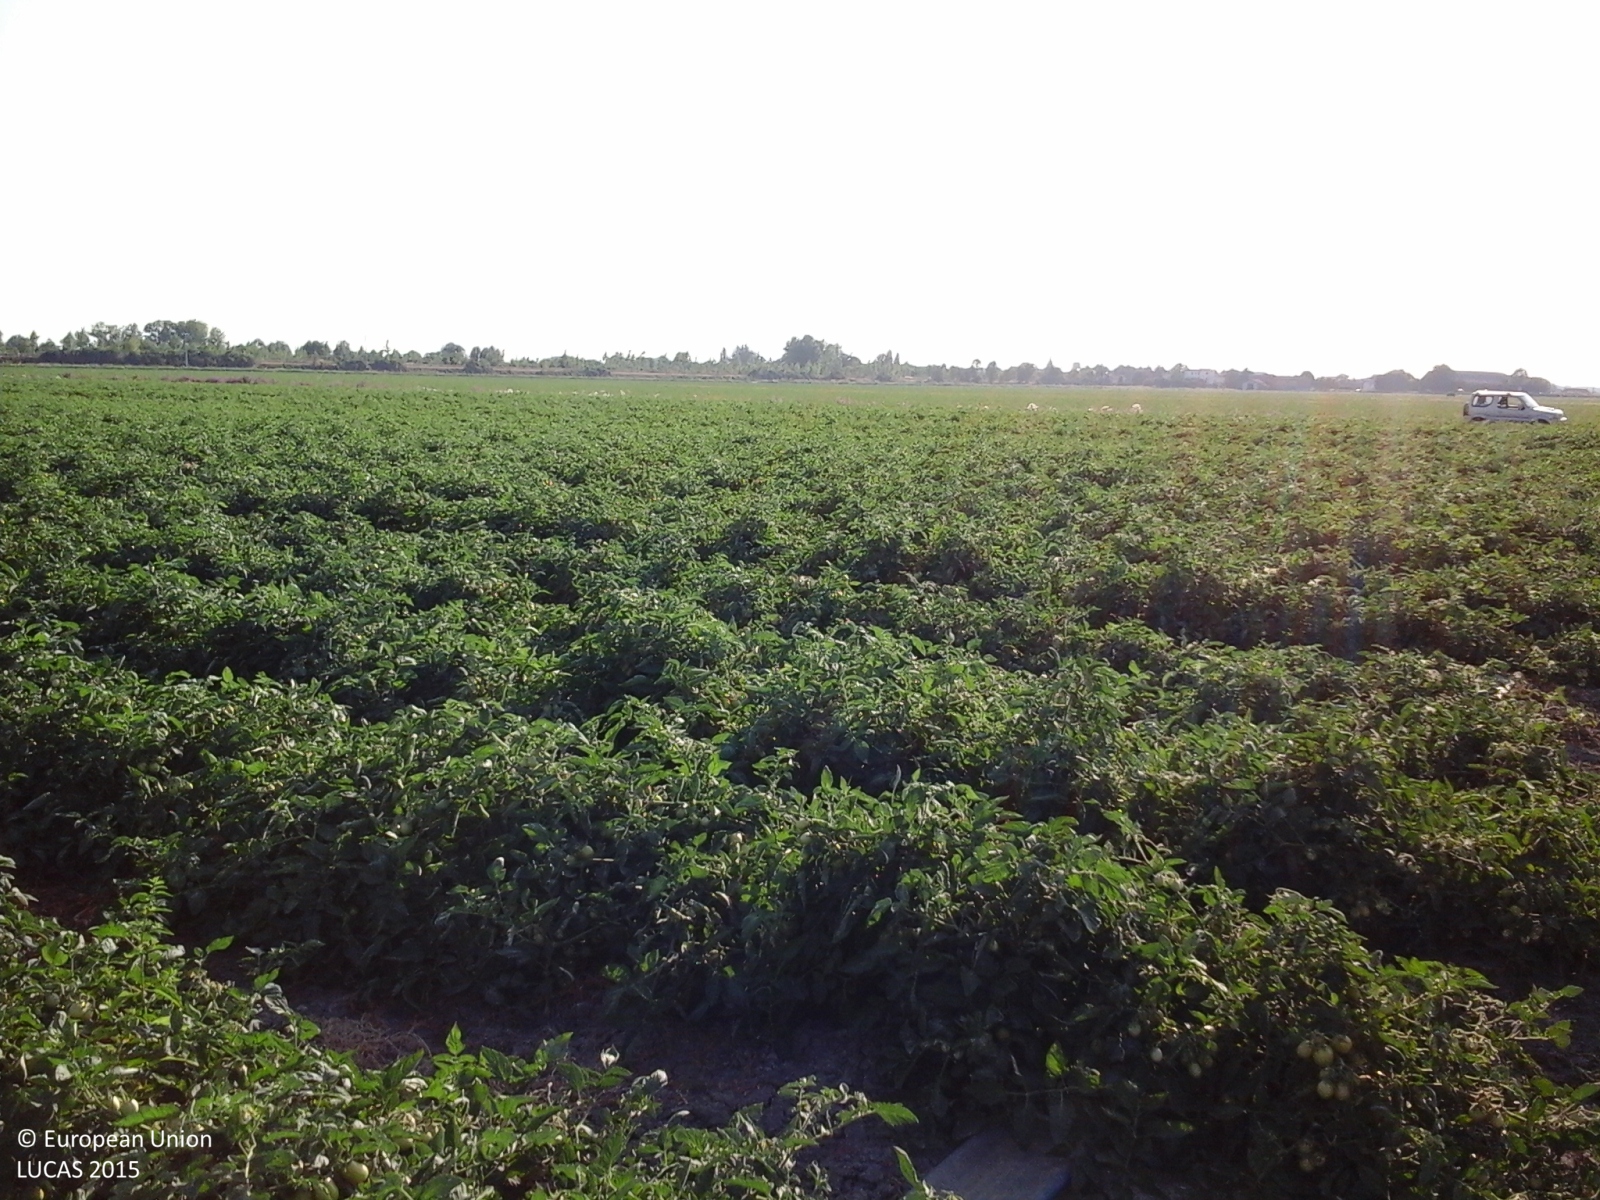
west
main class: Cropland
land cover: Tomatoes
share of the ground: > 75 %
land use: Agriculture (excluding fallow land and kitchen gardens)
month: July
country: IT
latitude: 44.7178
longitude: 11.5496
